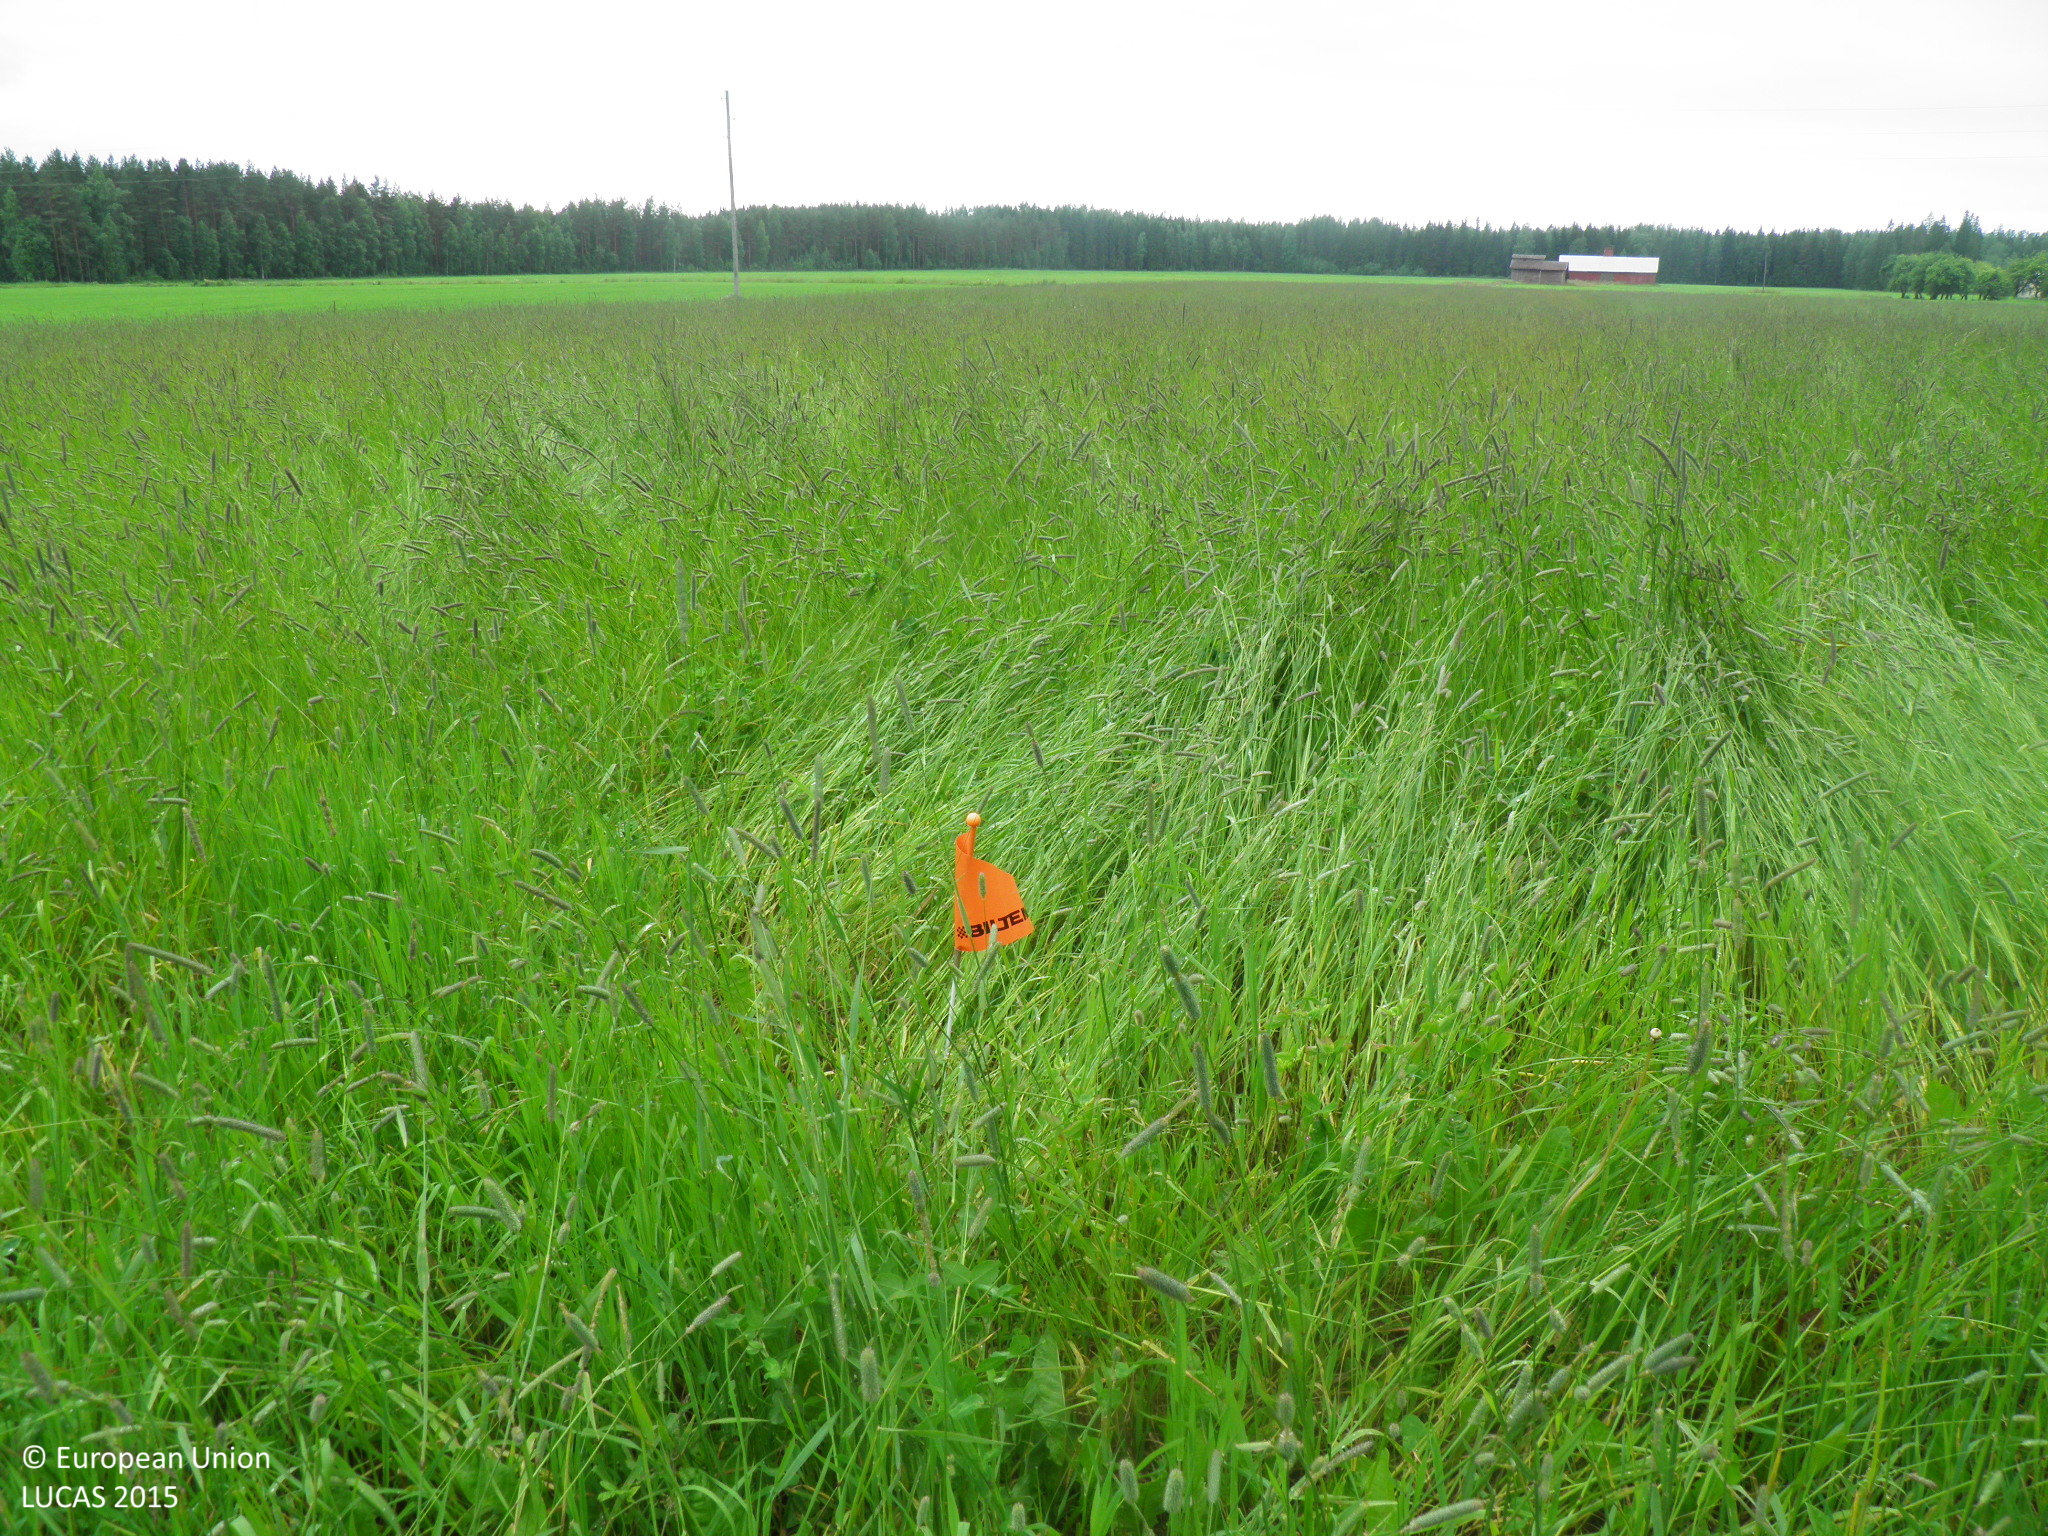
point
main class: Cropland
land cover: Temporary grasslands
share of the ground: > 75 %
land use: Agriculture (excluding fallow land and kitchen gardens)
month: July
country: FI
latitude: 60.6844
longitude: 22.8732
